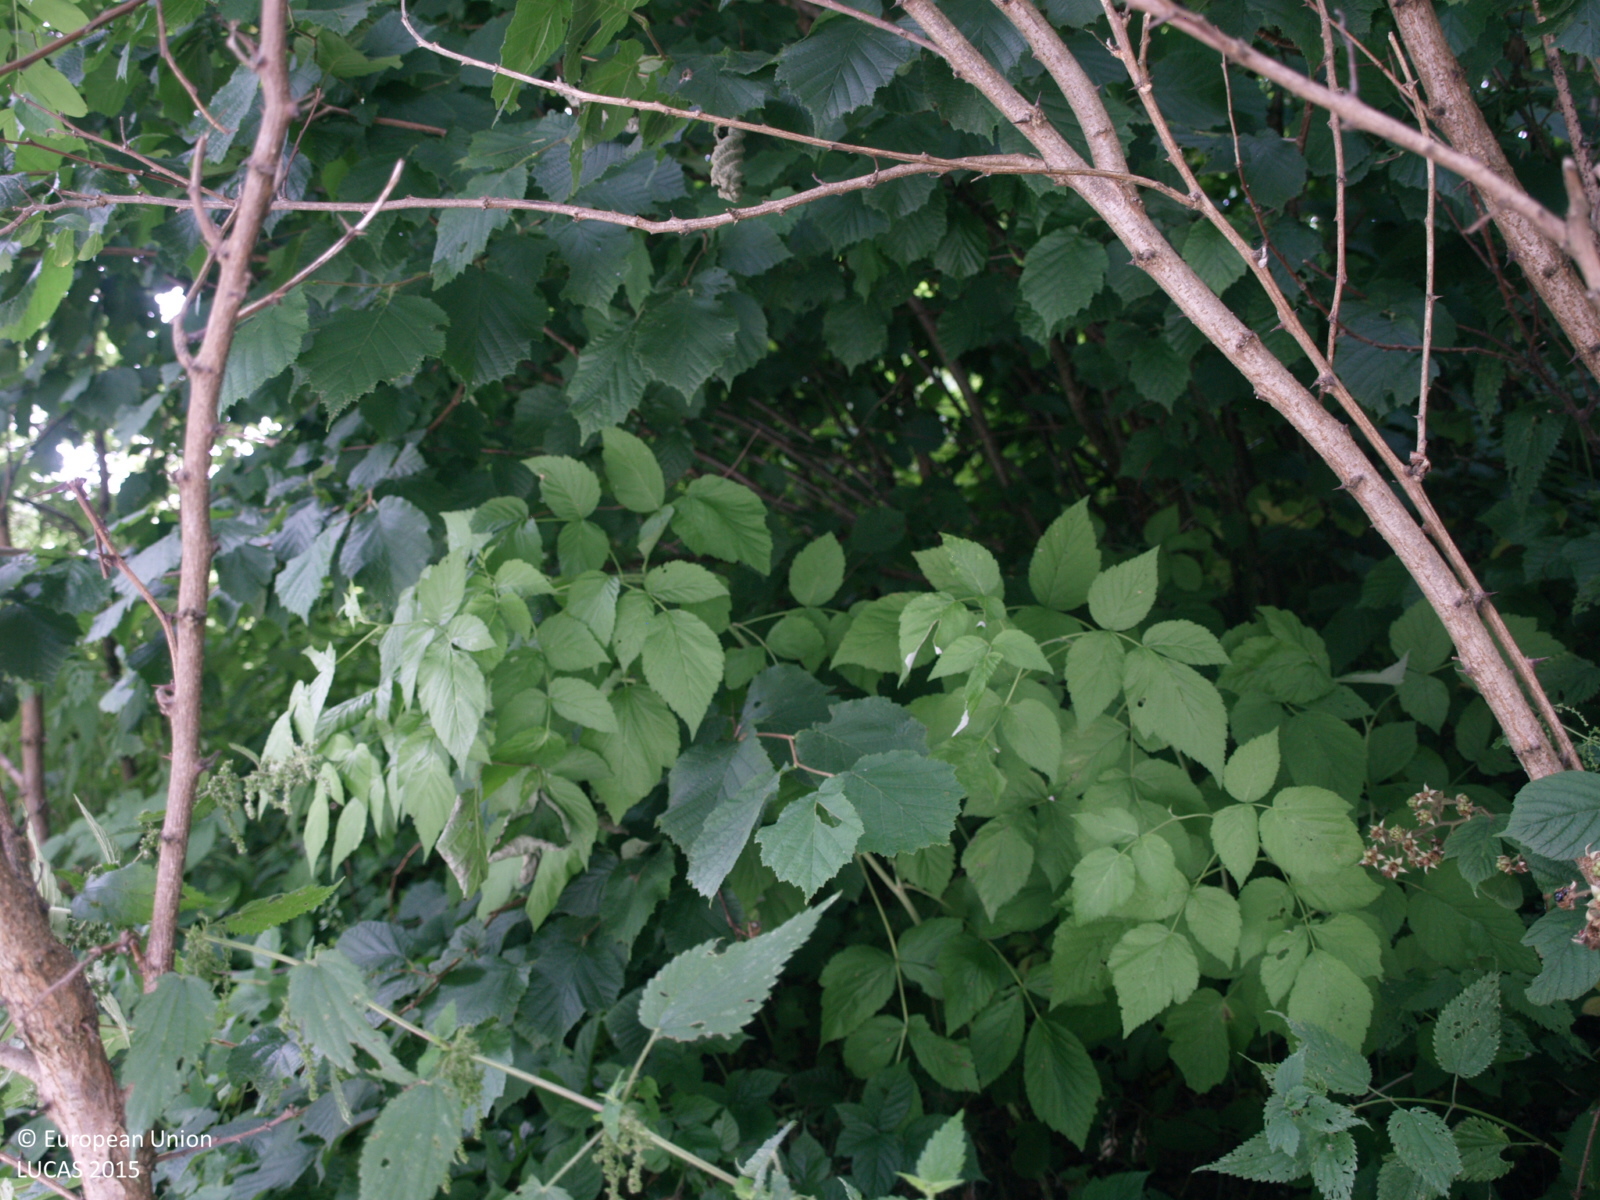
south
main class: Woodland
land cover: Broadleaved woodland
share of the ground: > 75 %
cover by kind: shrubs 60 %, broadleaved forest trees 40 %
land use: Semi-natural and natural areas not in use
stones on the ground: 10 - 25 %
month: May
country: IT
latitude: 45.8775
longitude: 11.0678
